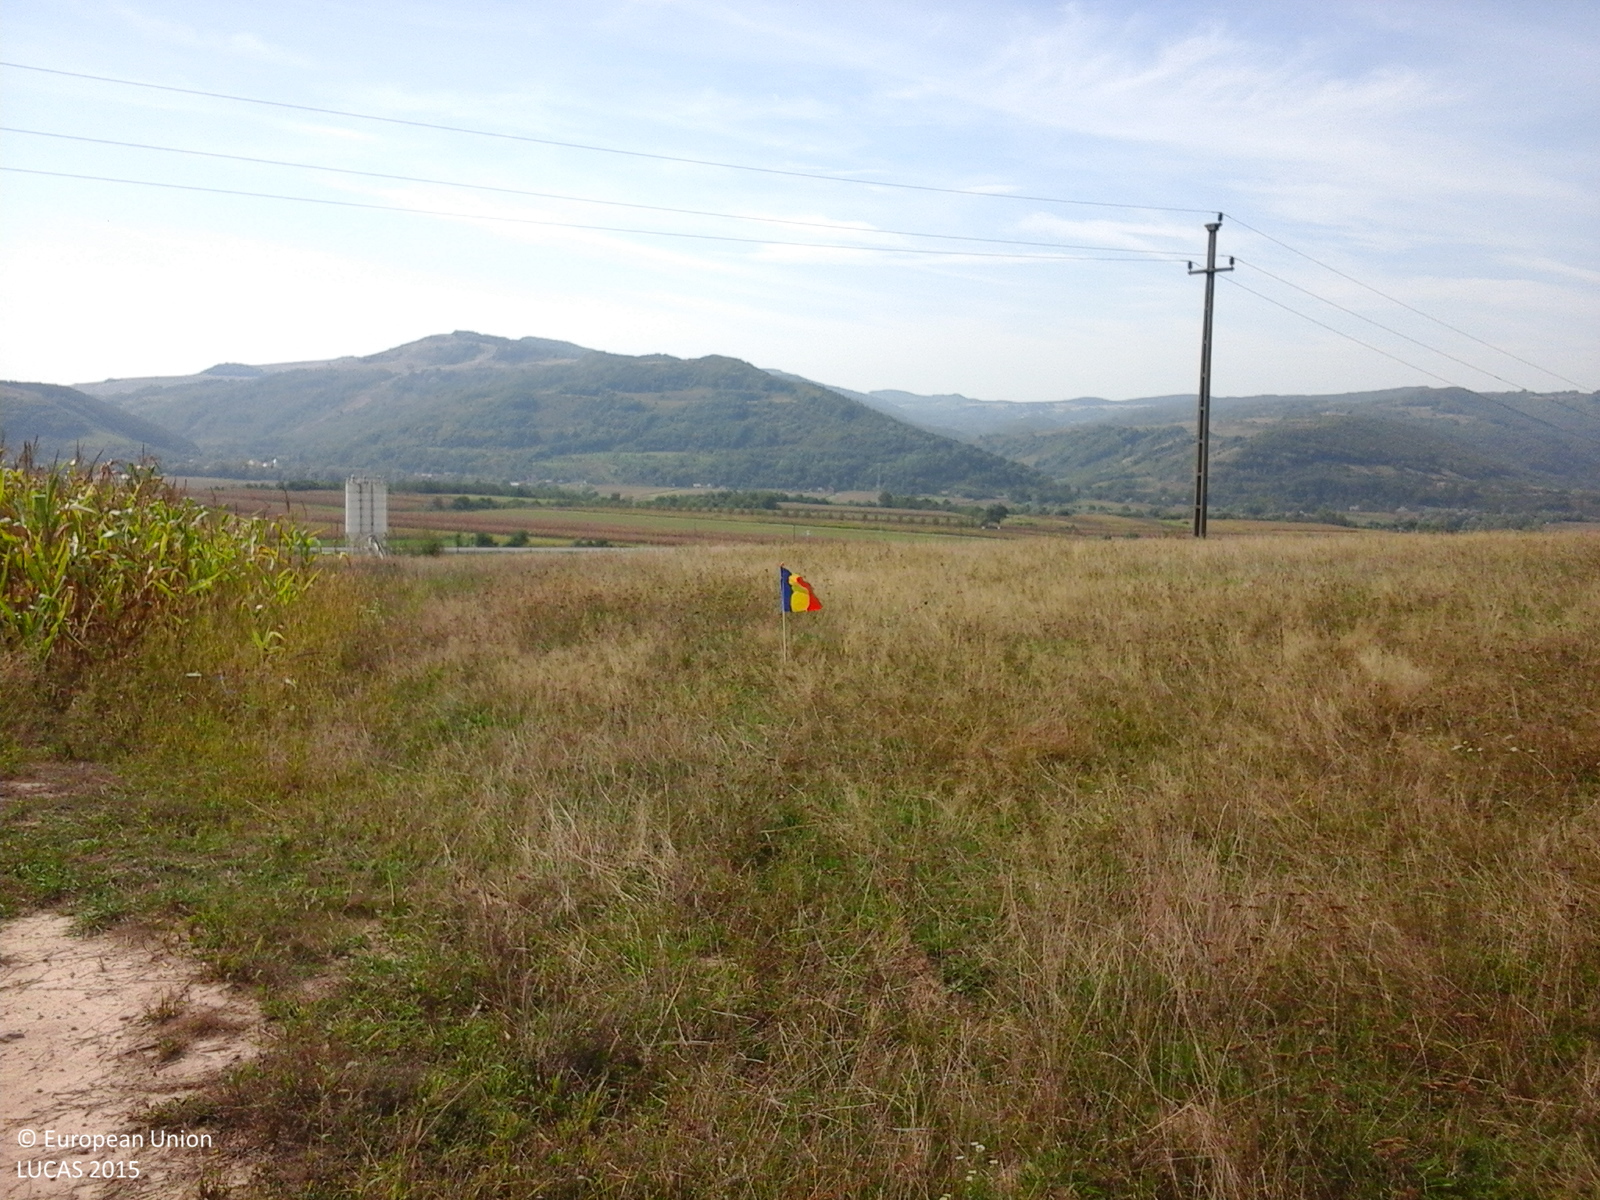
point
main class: Grassland
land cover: Grassland without tree/shrub cover
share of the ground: > 75 %
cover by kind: herbaceous plants 100 %
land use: Agriculture (excluding fallow land and kitchen gardens)
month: September
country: RO
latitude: 47.2261
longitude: 23.7727
